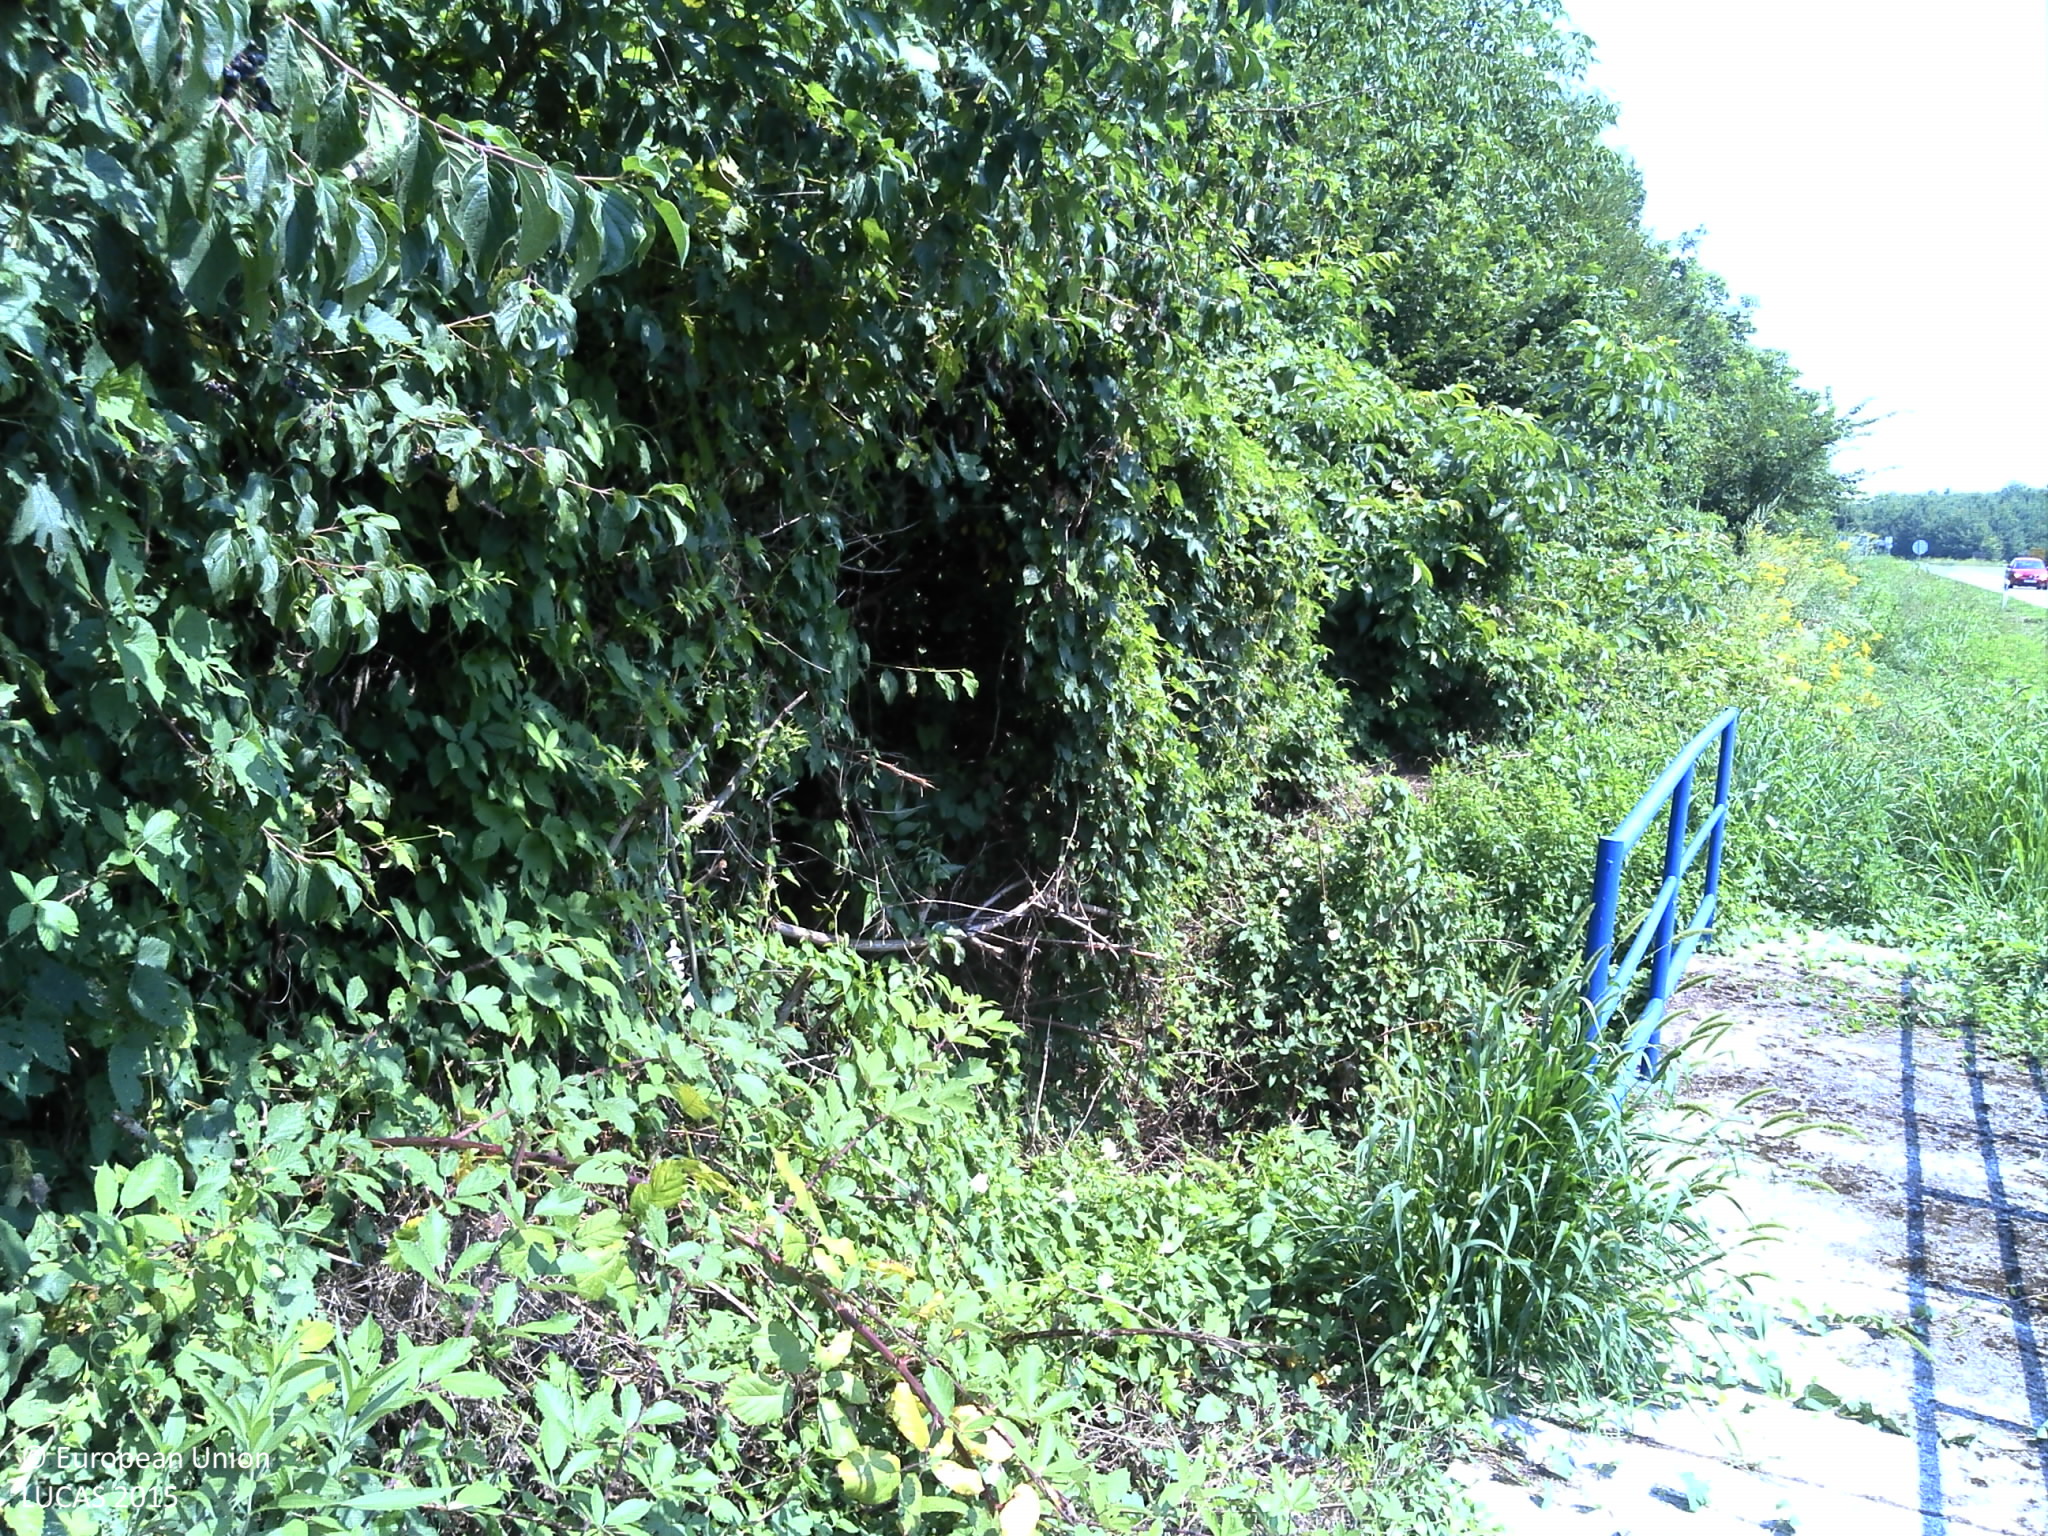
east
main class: Shrubland
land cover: Shrubland with sparse tree cover
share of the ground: > 75 %
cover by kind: shrubs 95 %, broadleaved forest trees 5 %
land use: Forestry
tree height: > 5 m
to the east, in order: Shrubland with sparse tree cover; Broadleaved woodland; Tracks; Ditches and canals; Paved roads, cycling and walking lanes; Electric lines; Broadleaved woodland
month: August
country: HR
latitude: 45.7101
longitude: 17.2075
